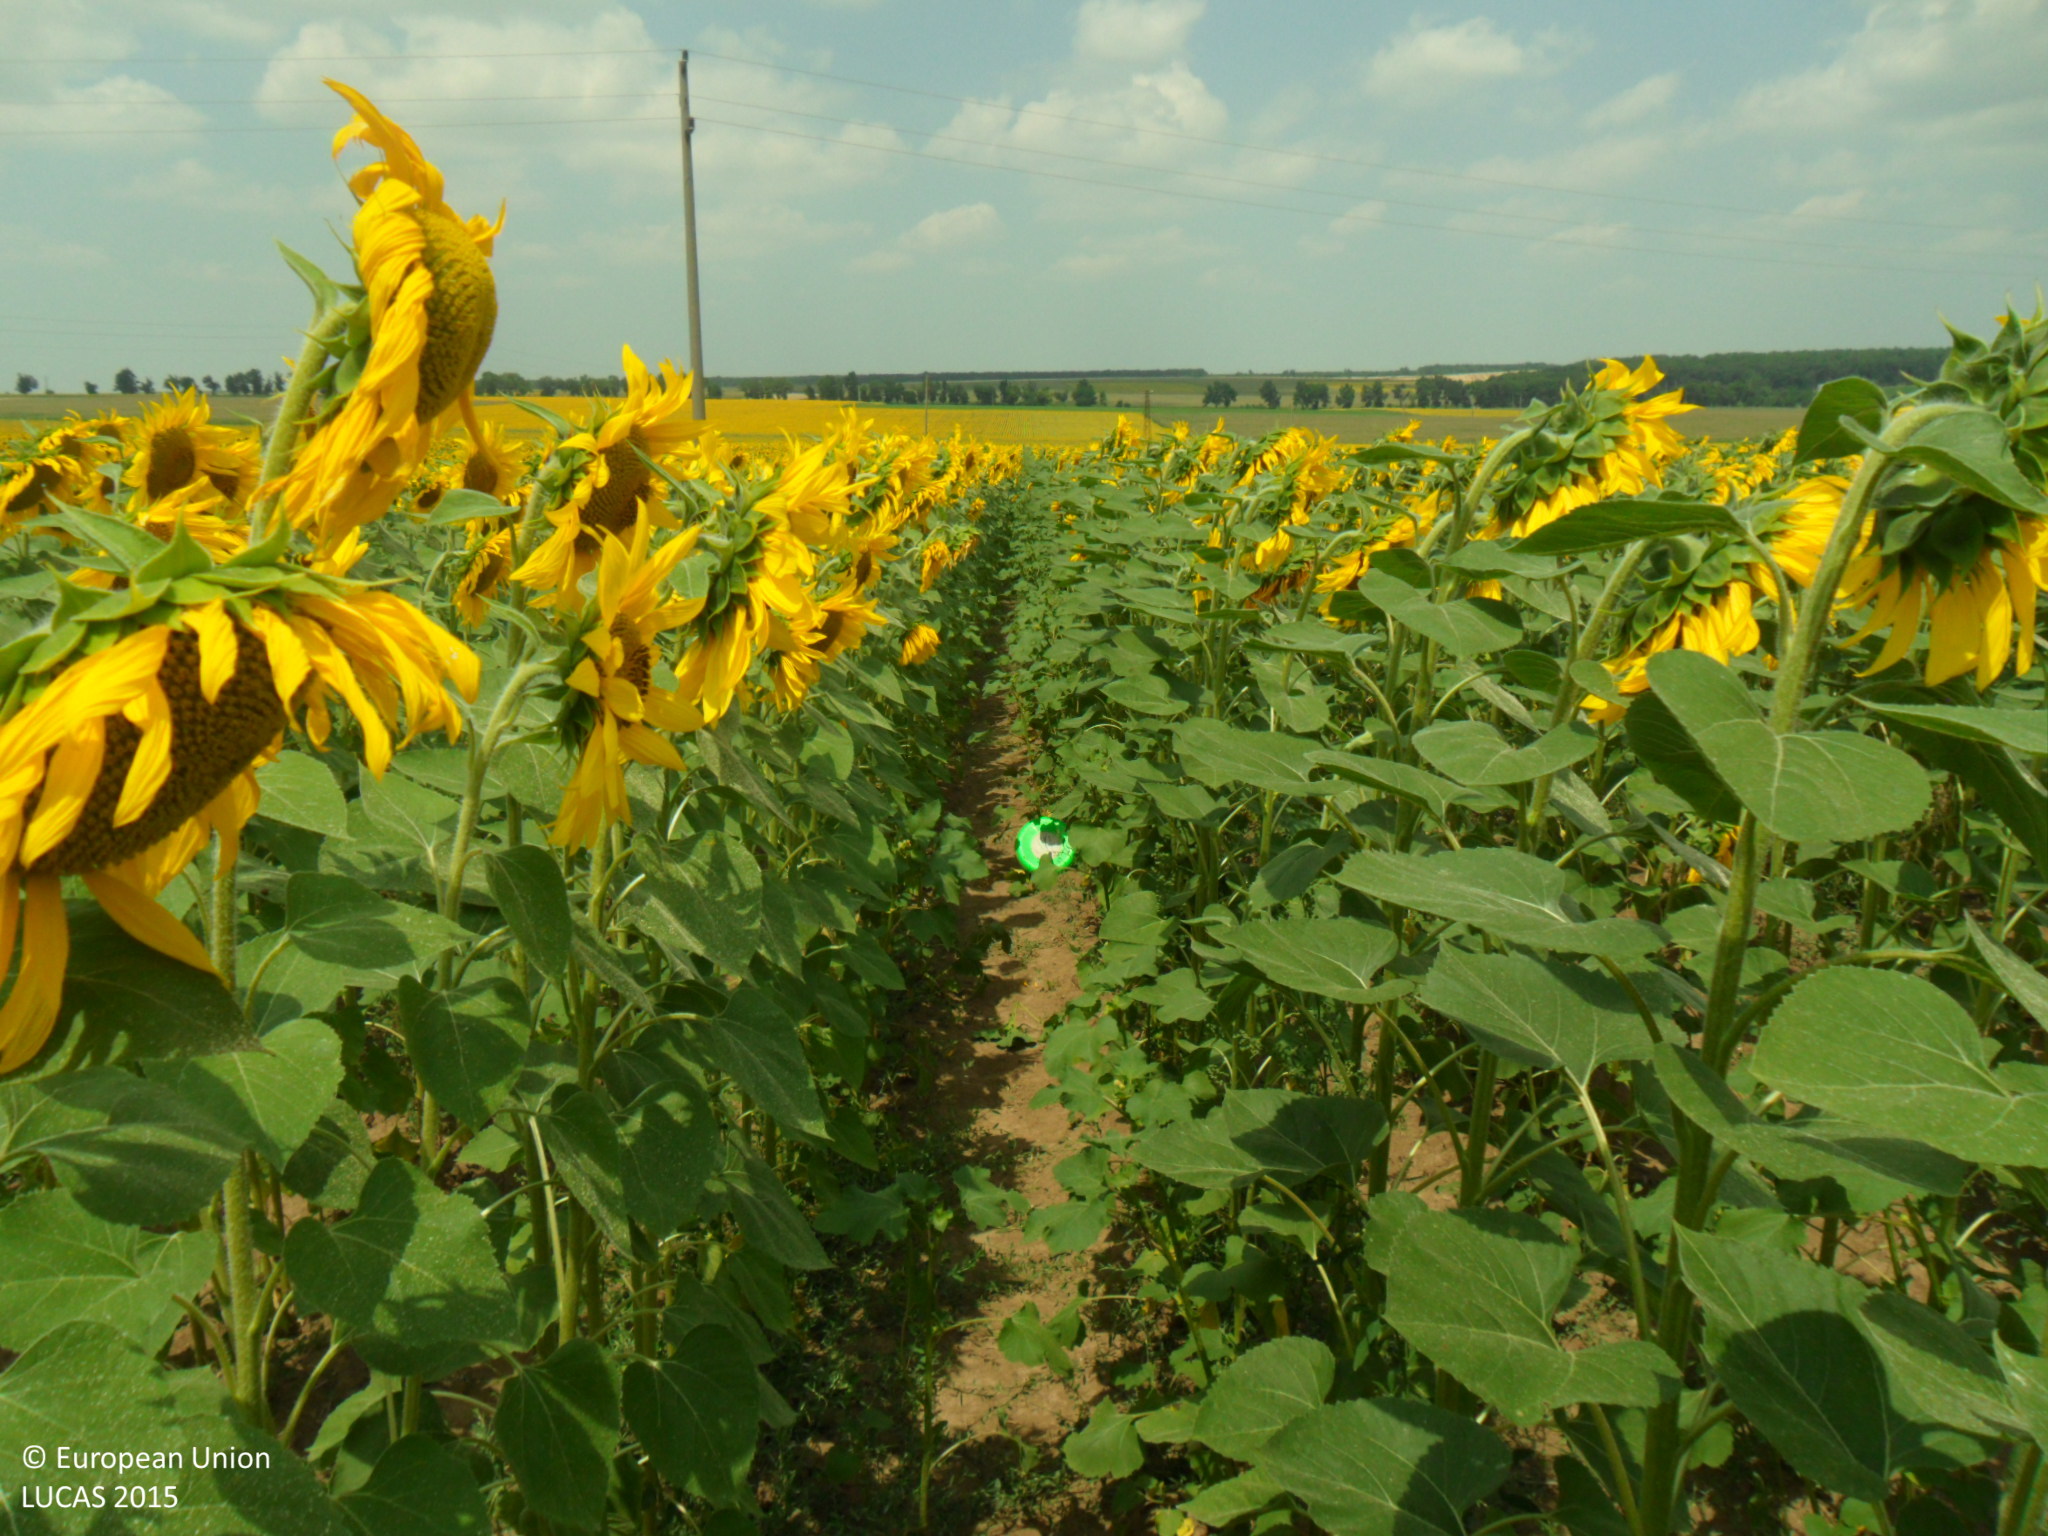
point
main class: Cropland
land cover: Sunflower
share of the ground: > 75 %
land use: Agriculture (excluding fallow land and kitchen gardens)
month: July
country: BG
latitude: 43.5838
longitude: 26.9732
